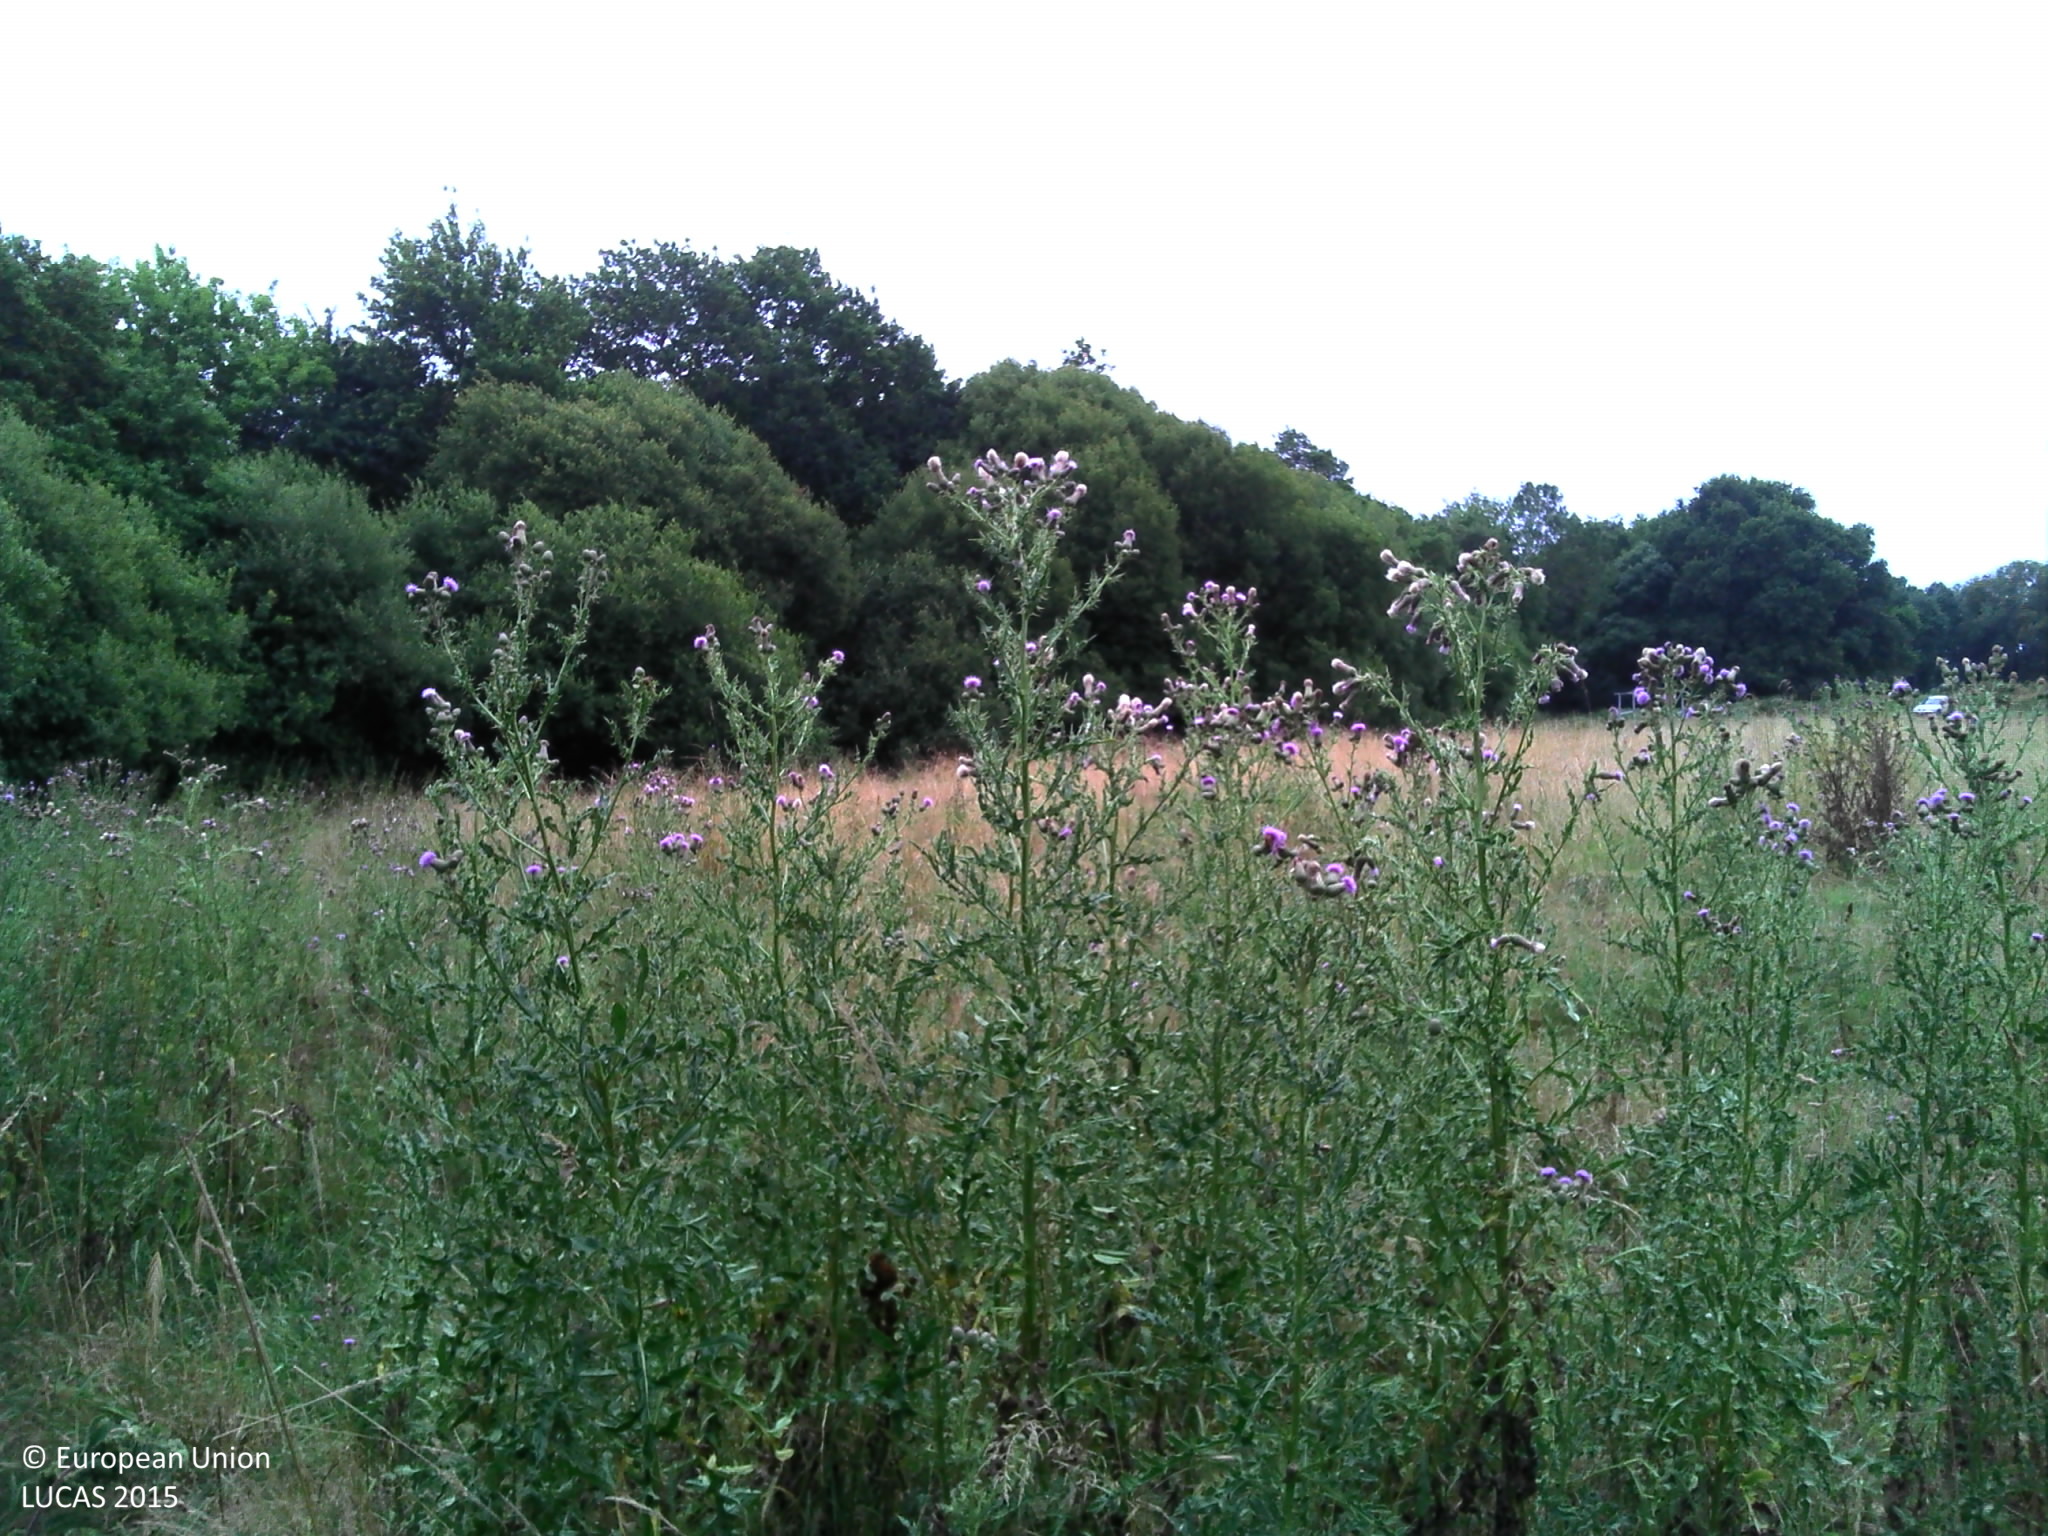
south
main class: Woodland
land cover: Broadleaved woodland
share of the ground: > 75 %
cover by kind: broadleaved forest trees 50 %, shrubs 30 %, herbaceous plants 10 %, consolidated bare surface 10 %
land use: Forestry
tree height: < 5 m
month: July
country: FR
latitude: 47.7141
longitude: -3.2262
